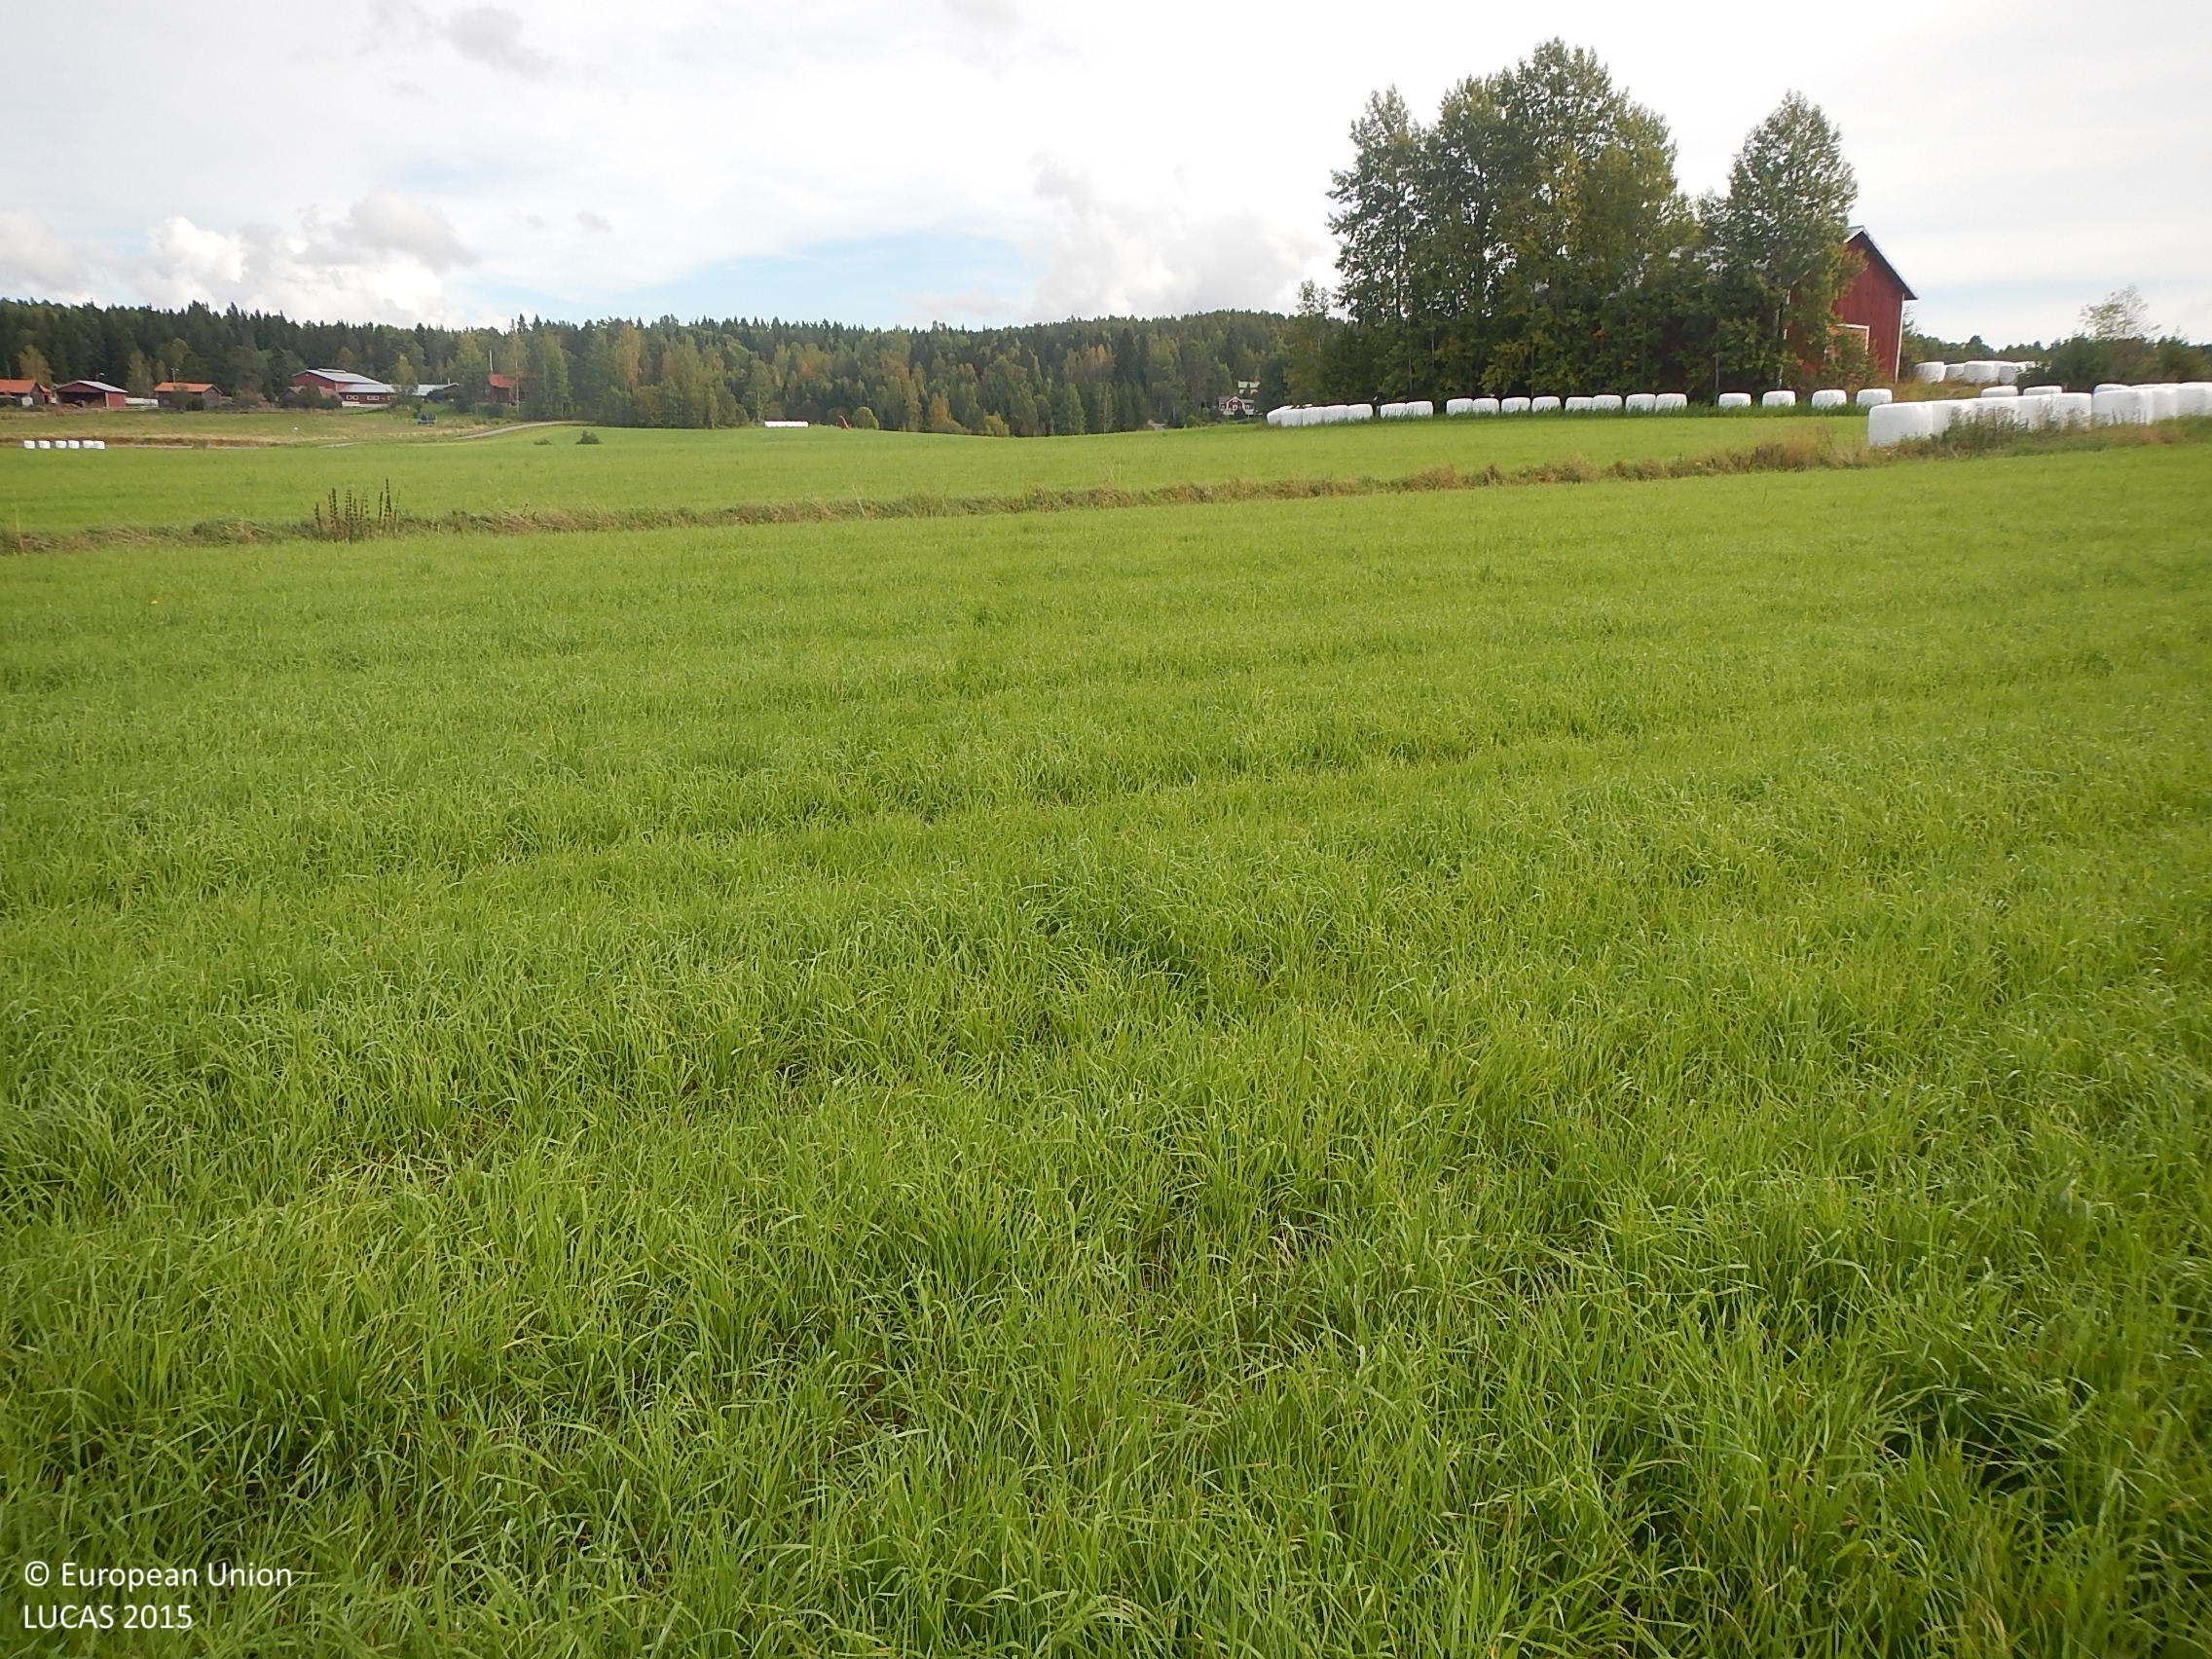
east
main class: Cropland
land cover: Temporary grasslands
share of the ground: > 75 %
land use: Agriculture (excluding fallow land and kitchen gardens)
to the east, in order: Temporary grasslands; Ditches and canals; Grass margins; Temporary grasslands; Ditches and canals; Grass margins; Tracks; Grass margins; Ditches and canals; Temporary grasslands
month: September
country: FI
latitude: 61.4357
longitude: 23.0649
